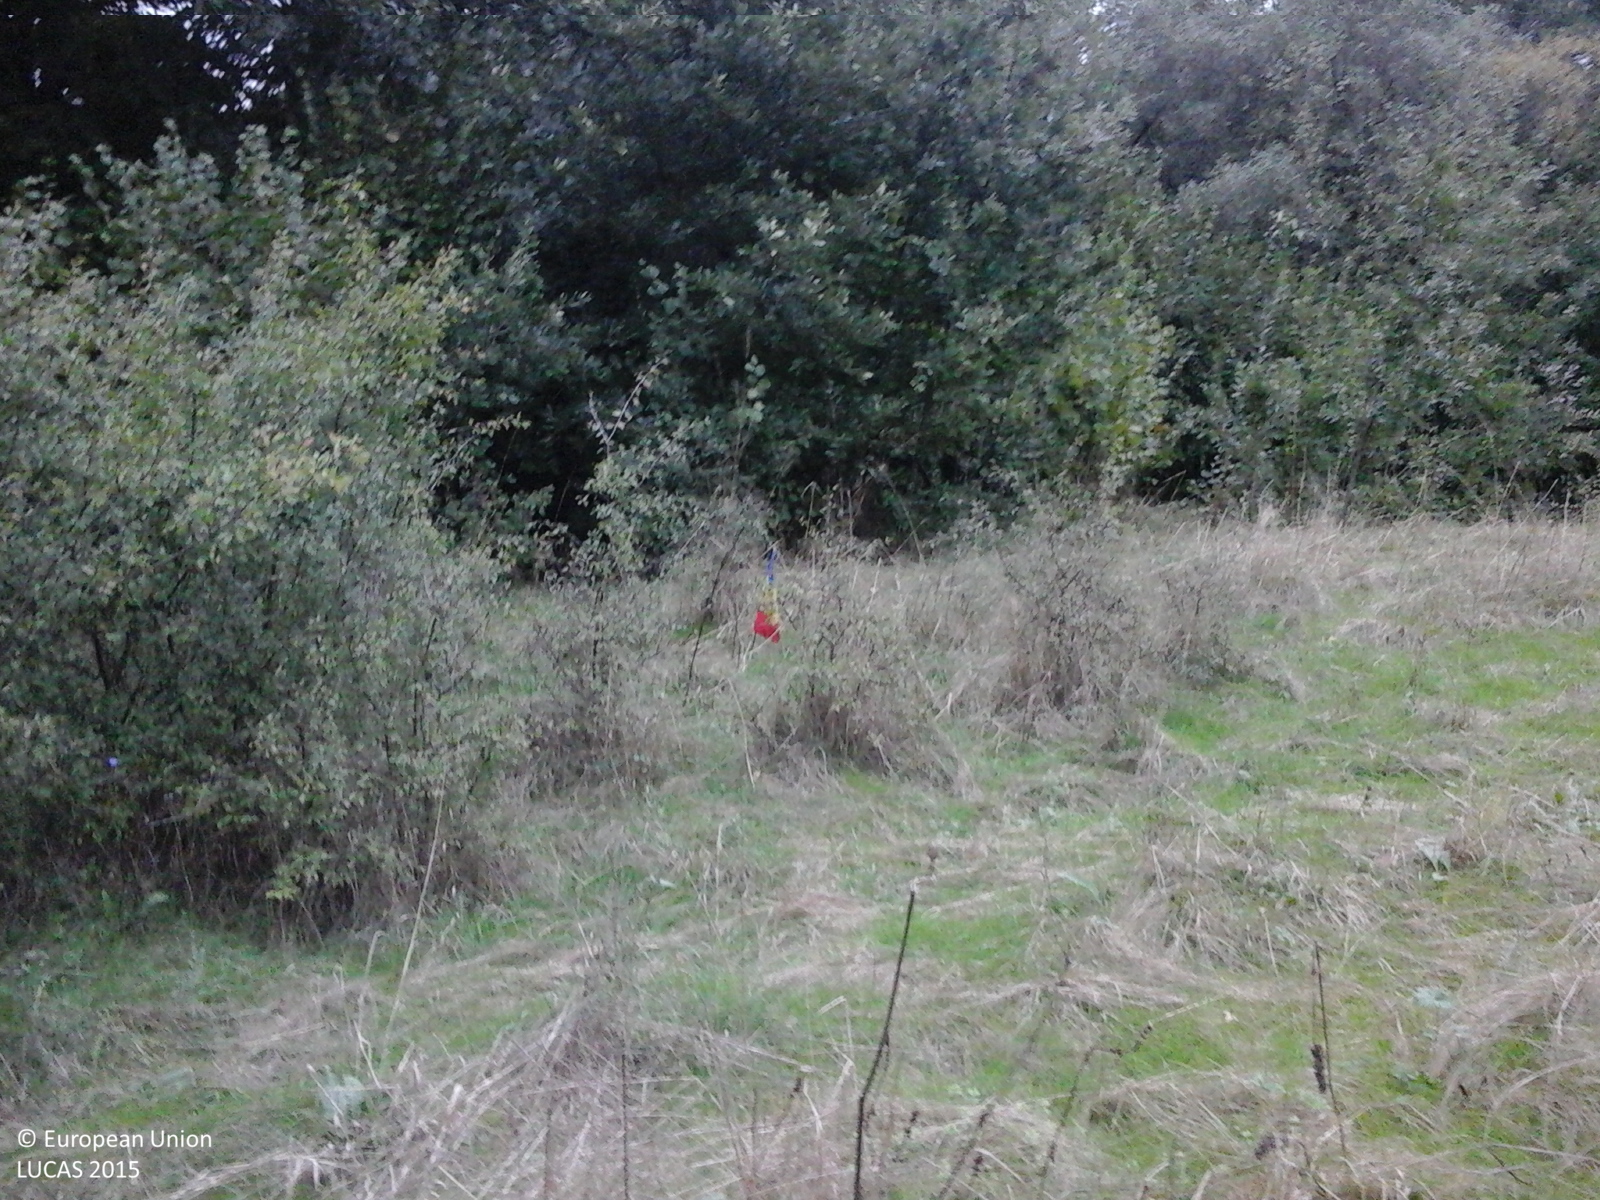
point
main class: Grassland
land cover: Grassland with sparse tree/shrub cover
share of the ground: > 75 %
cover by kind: herbaceous plants 90 %, broadleaved forest trees 5 %, shrubs 5 %
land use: Agriculture (excluding fallow land and kitchen gardens)
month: September
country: RO
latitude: 45.8868
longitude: 23.3992
